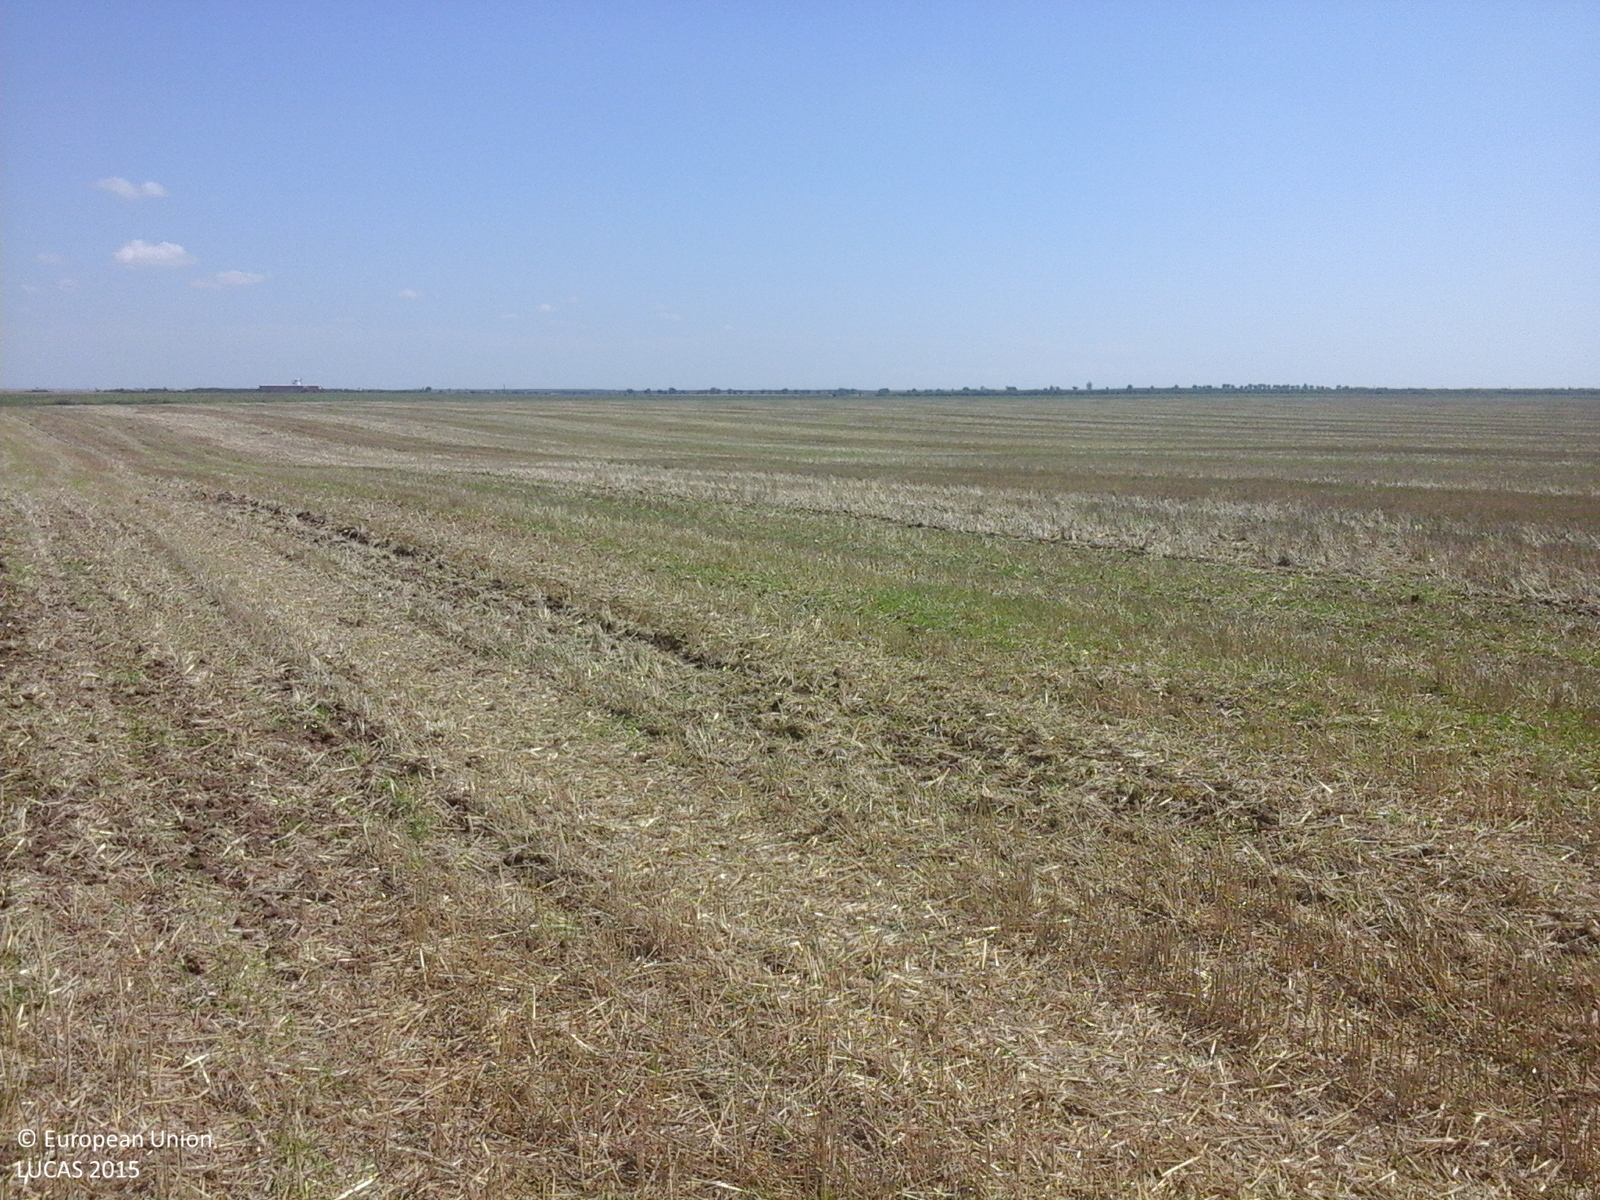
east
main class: Cropland
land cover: Common wheat
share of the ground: 50 - 75 %
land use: Agriculture (excluding fallow land and kitchen gardens)
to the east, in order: Common wheat
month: August
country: RO
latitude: 45.9466
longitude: 21.1636
